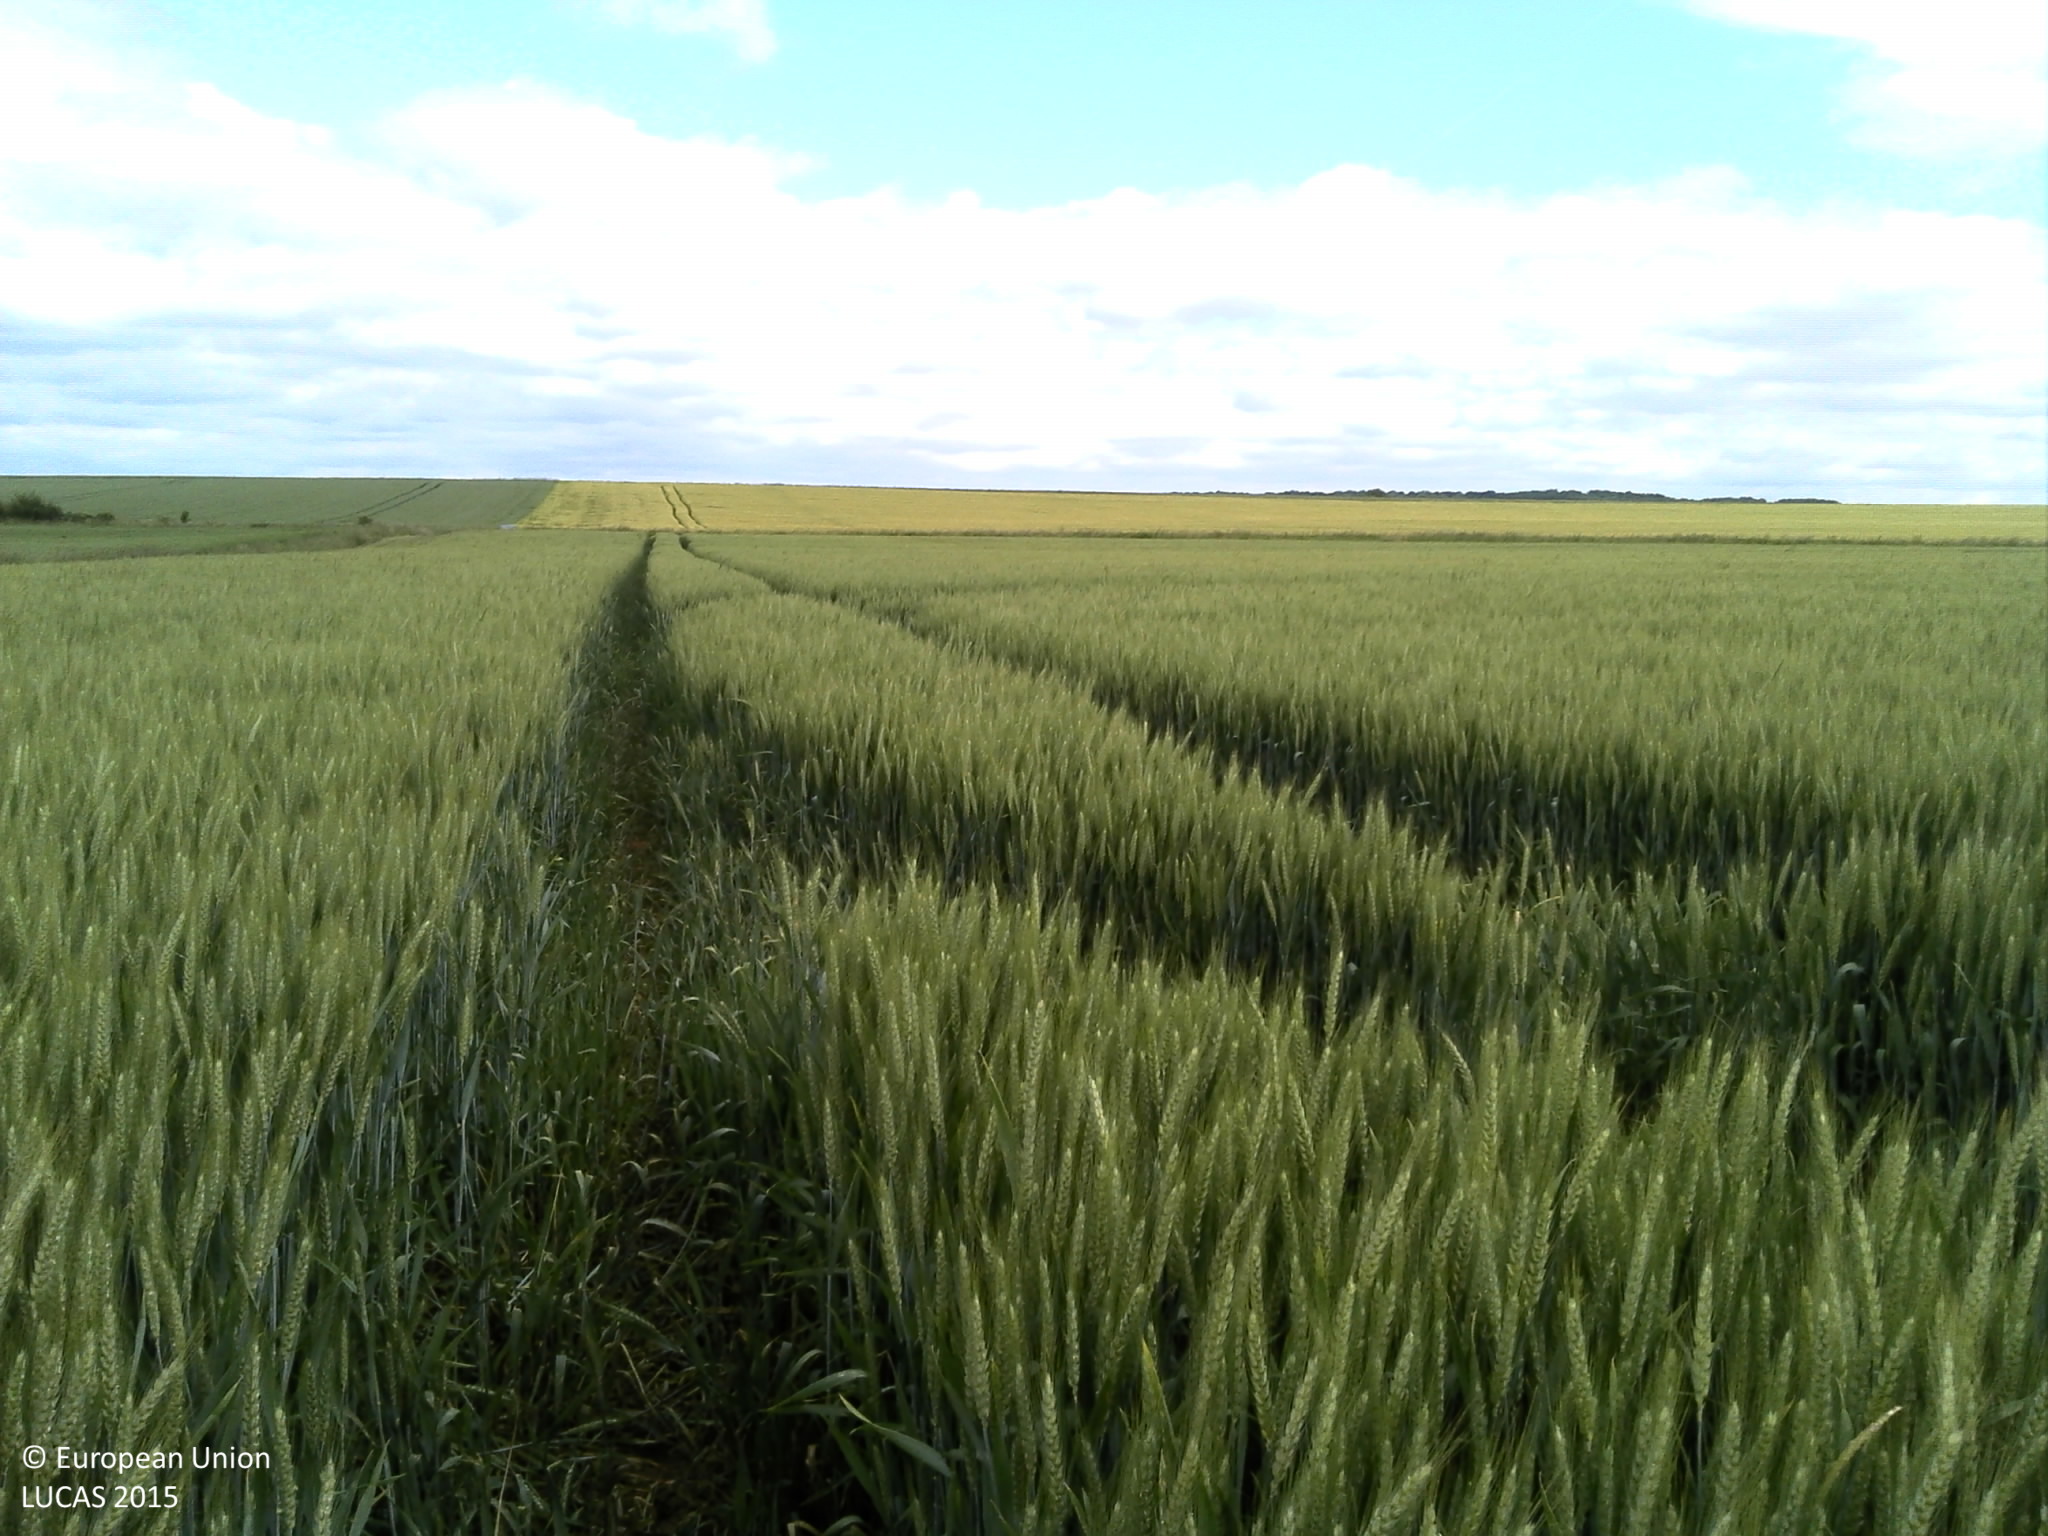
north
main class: Cropland
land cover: Common wheat
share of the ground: > 75 %
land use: Agriculture (excluding fallow land and kitchen gardens)
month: June
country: FR
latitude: 48.9862
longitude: 6.1873
